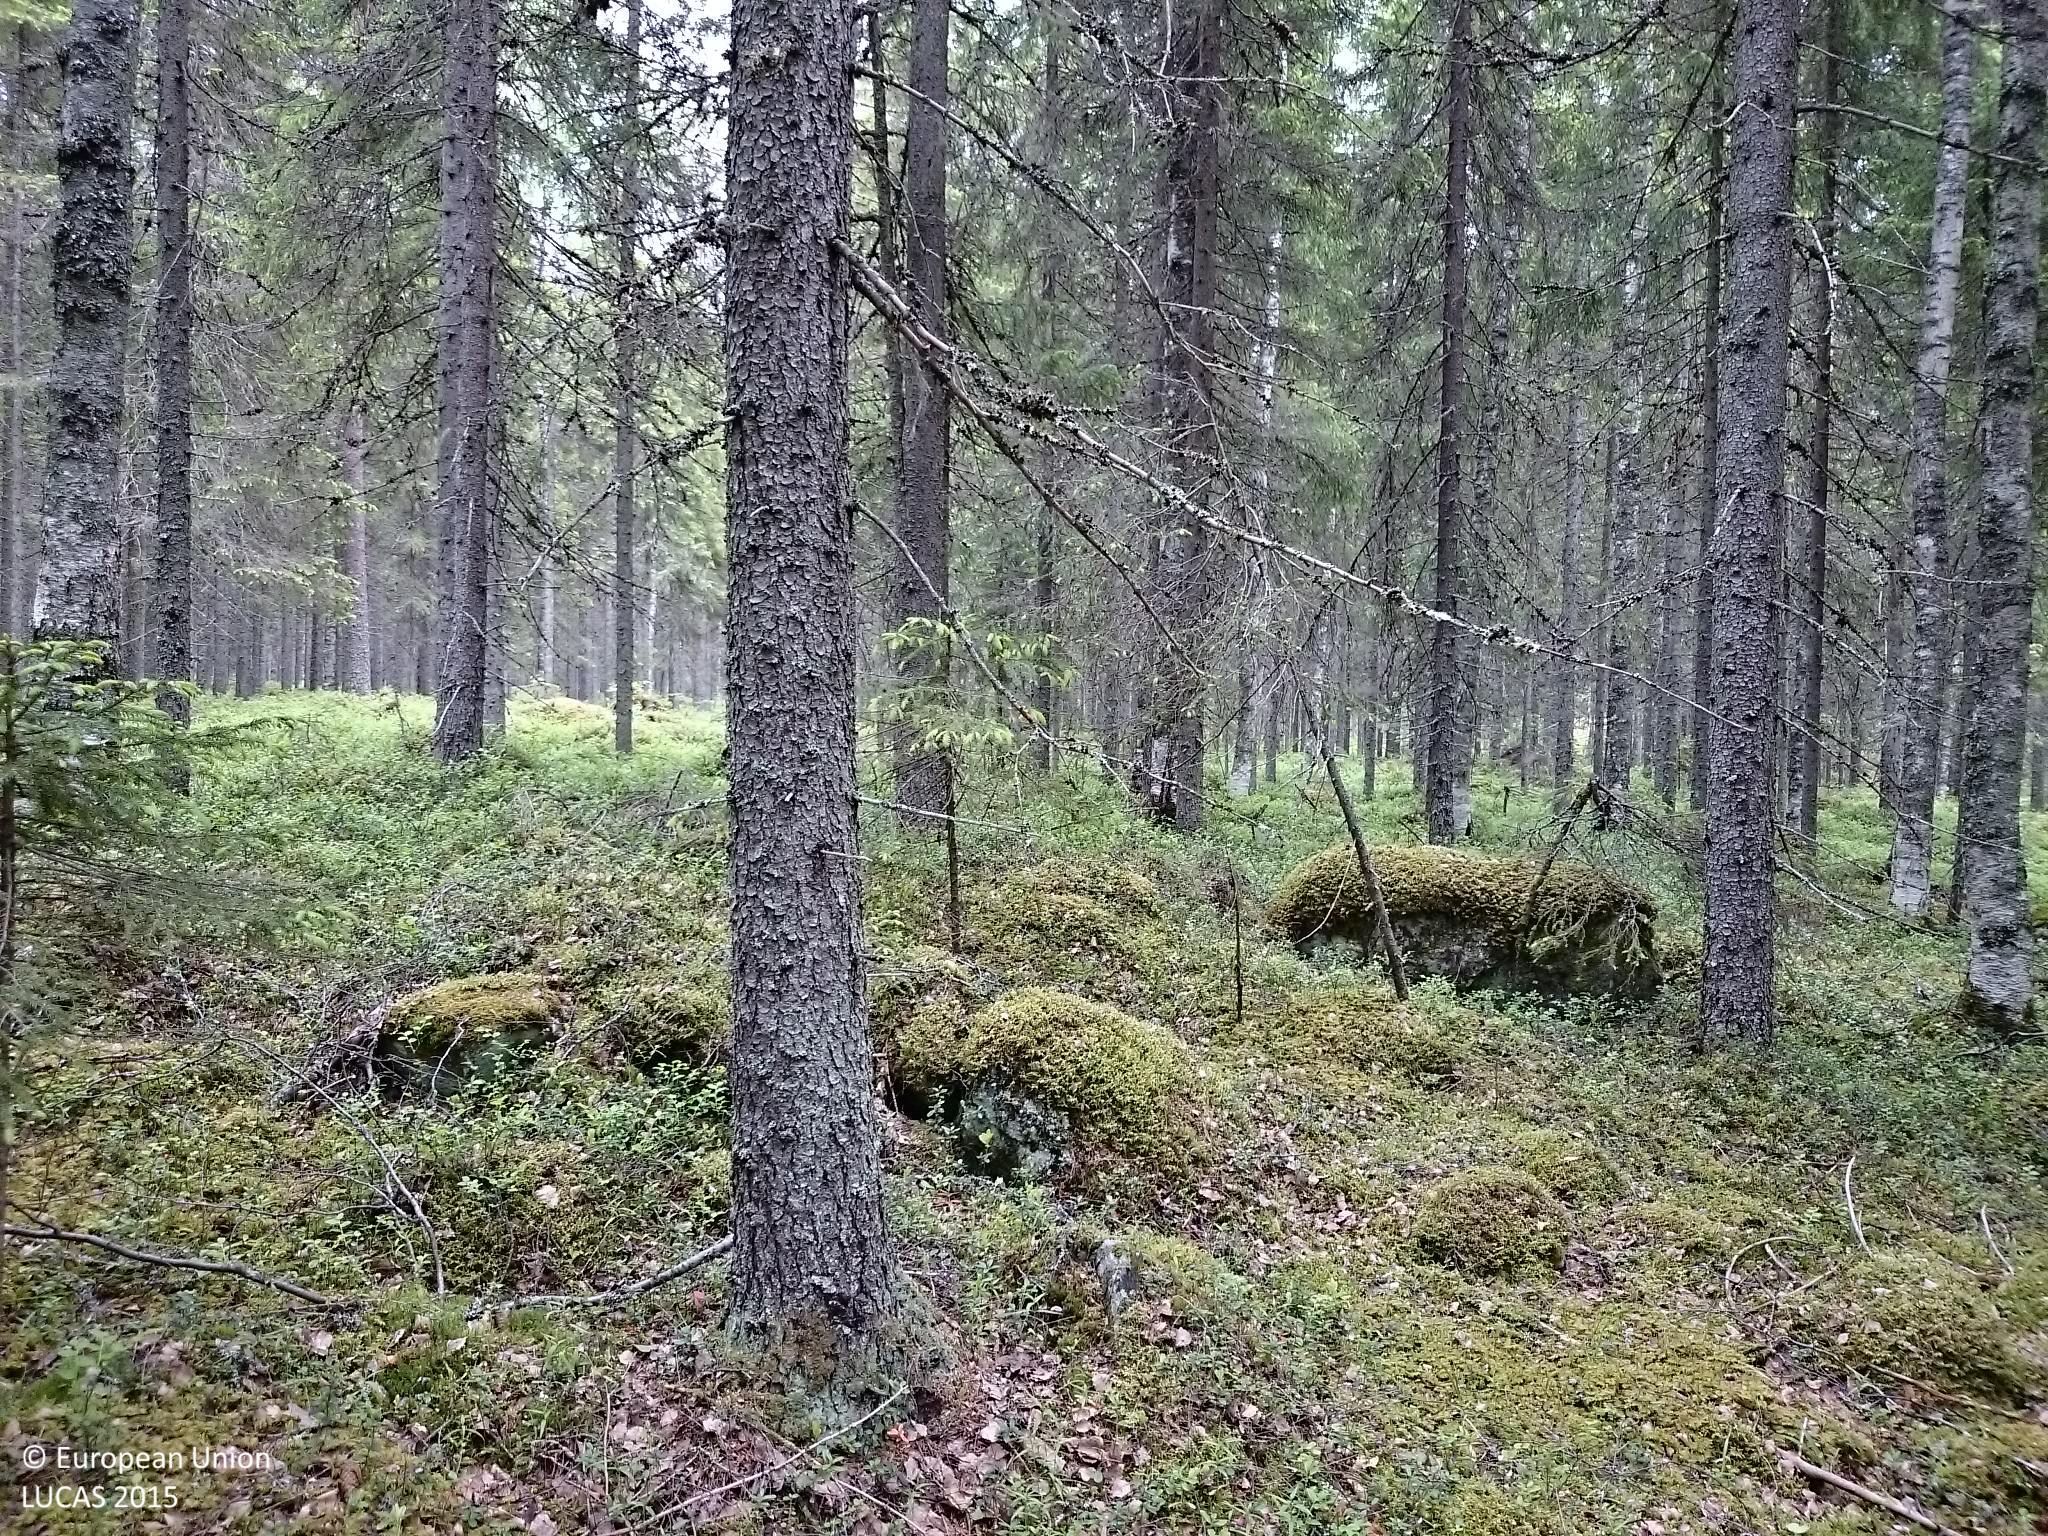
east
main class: Woodland
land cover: Spruce dominated mixed woodland
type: boreal forest
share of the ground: > 75 %
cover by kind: coniferous forest trees 60 %, broadleaved forest trees 20 %, shrubs 15 %, lichens and mosses 5 %
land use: Forestry
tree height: > 5 m
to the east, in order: Spruce dominated mixed woodland; Other coniferous woodland; Pine dominated coniferous woodland; Other coniferous woodland
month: June
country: SE
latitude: 64.1308
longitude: 20.6430
